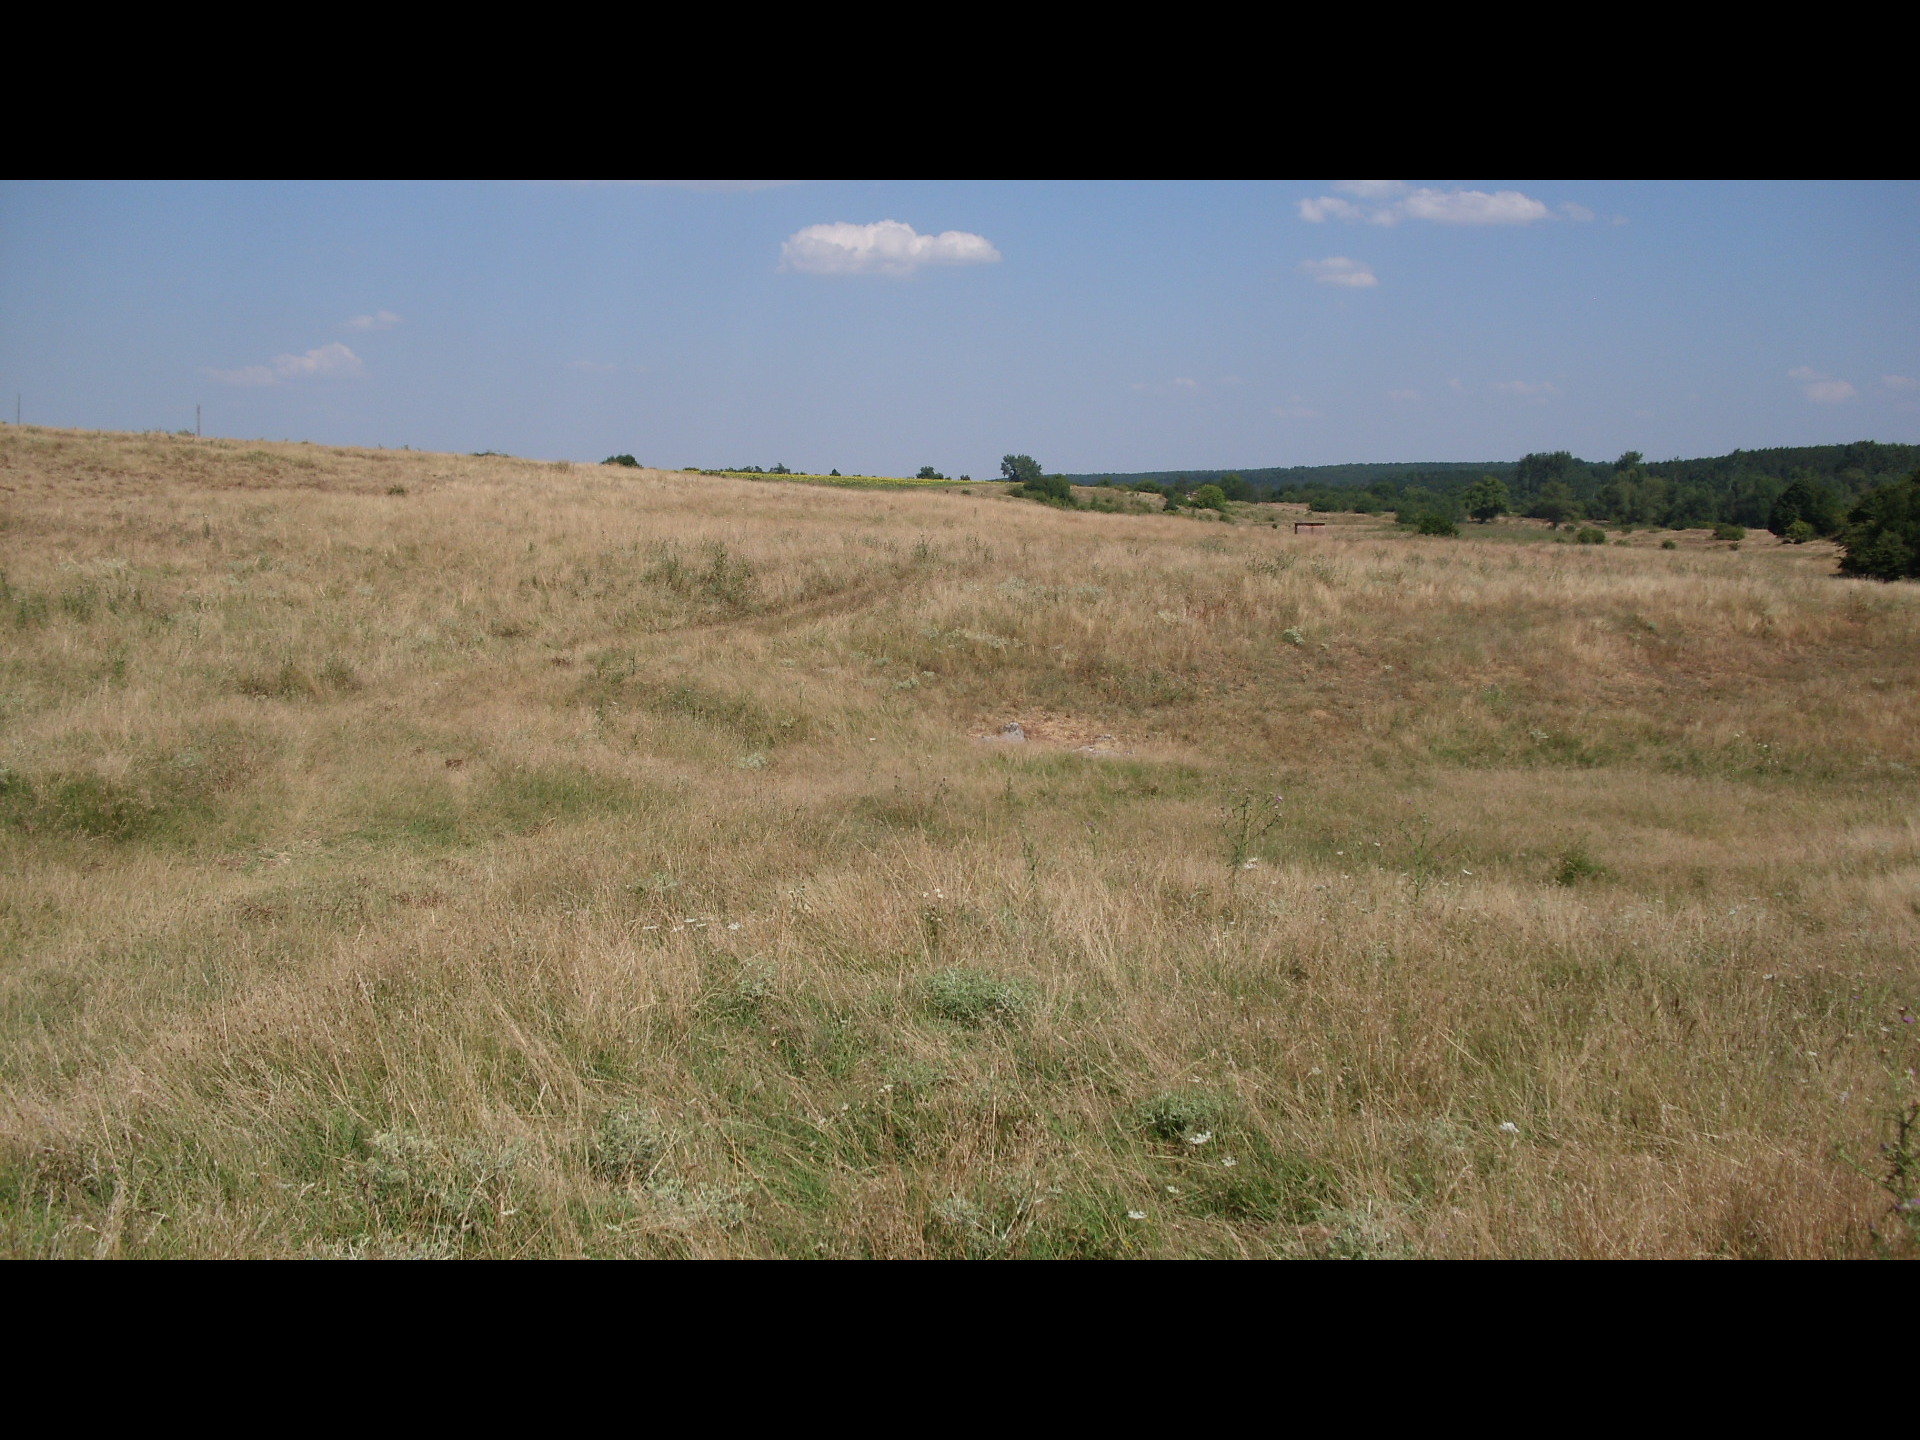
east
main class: Grassland
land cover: Grassland without tree/shrub cover
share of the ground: > 75 %
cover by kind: herbaceous plants 100 %
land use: Agriculture (excluding fallow land and kitchen gardens)
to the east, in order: Grassland without tree/shrub cover; Other structural elements; Grassland without tree/shrub cover
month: August
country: BG
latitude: 43.5476
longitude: 22.9965
